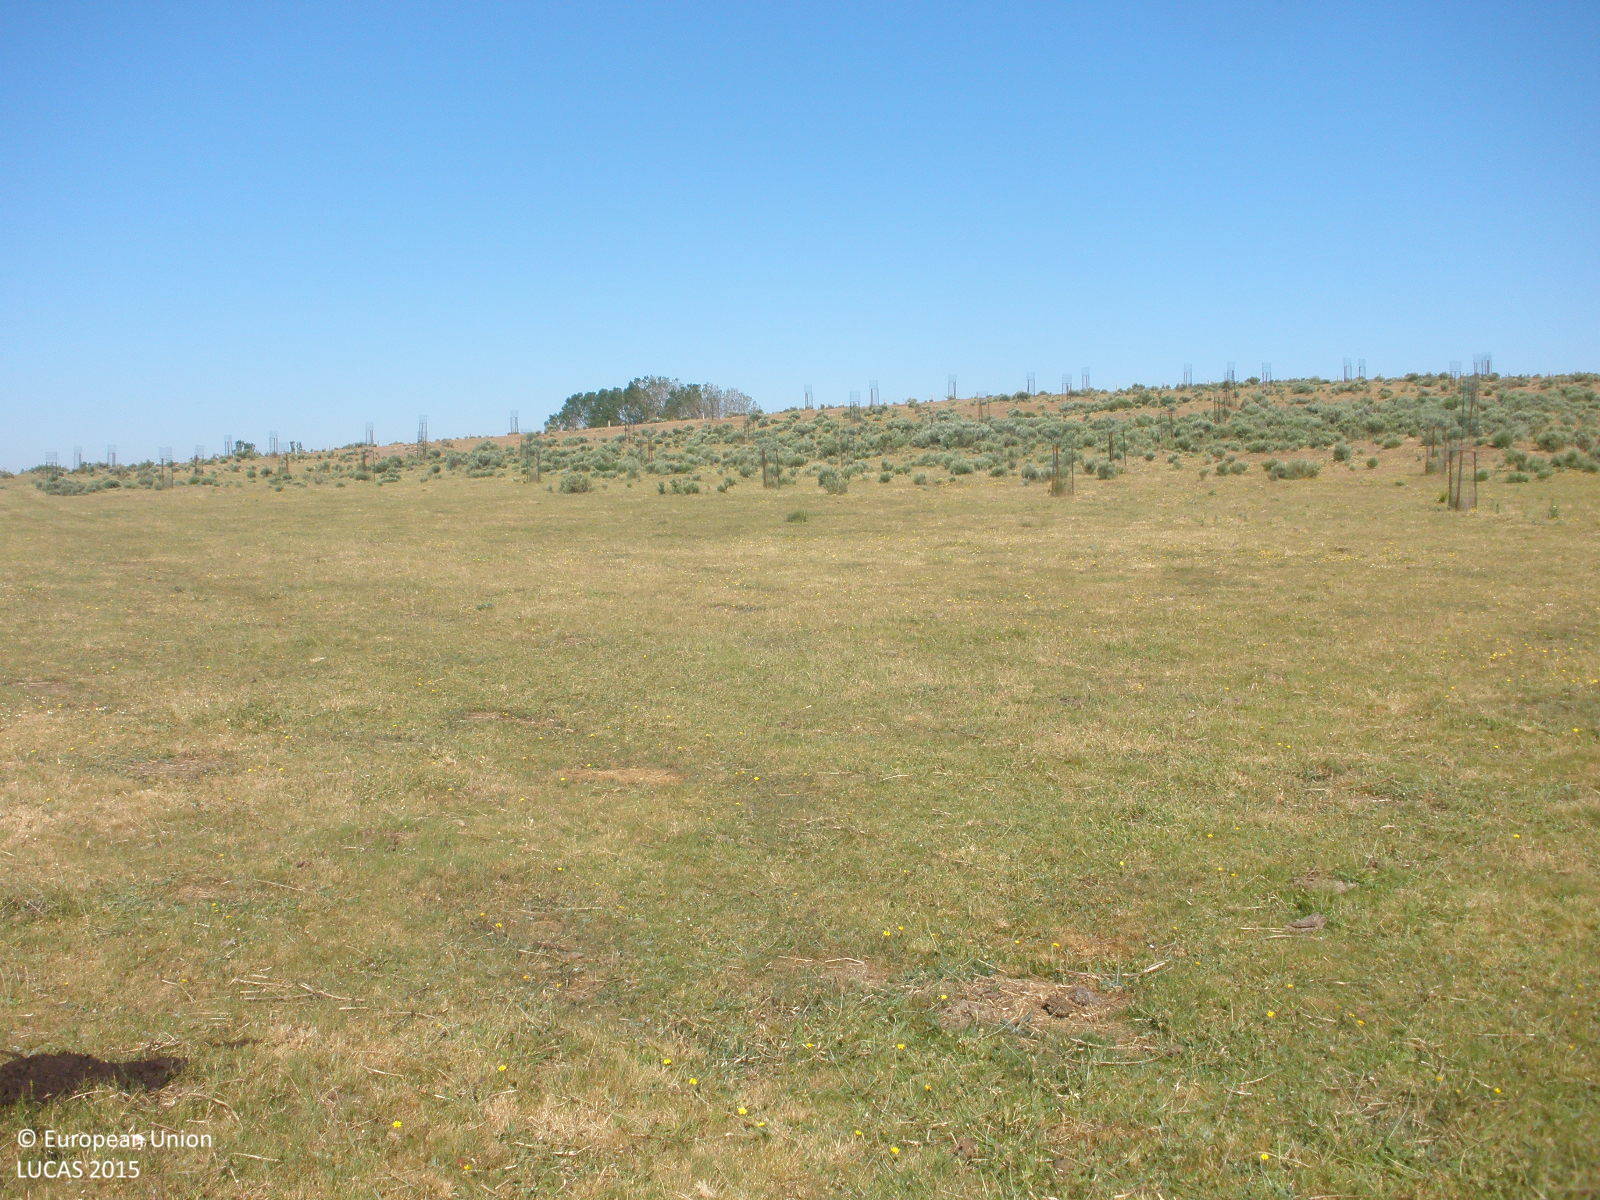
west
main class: Grassland
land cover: Grassland without tree/shrub cover
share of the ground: > 75 %
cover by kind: herbaceous plants 100 %
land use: Agriculture (excluding fallow land and kitchen gardens)
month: June
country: ES
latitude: 40.4356
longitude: -6.6527
